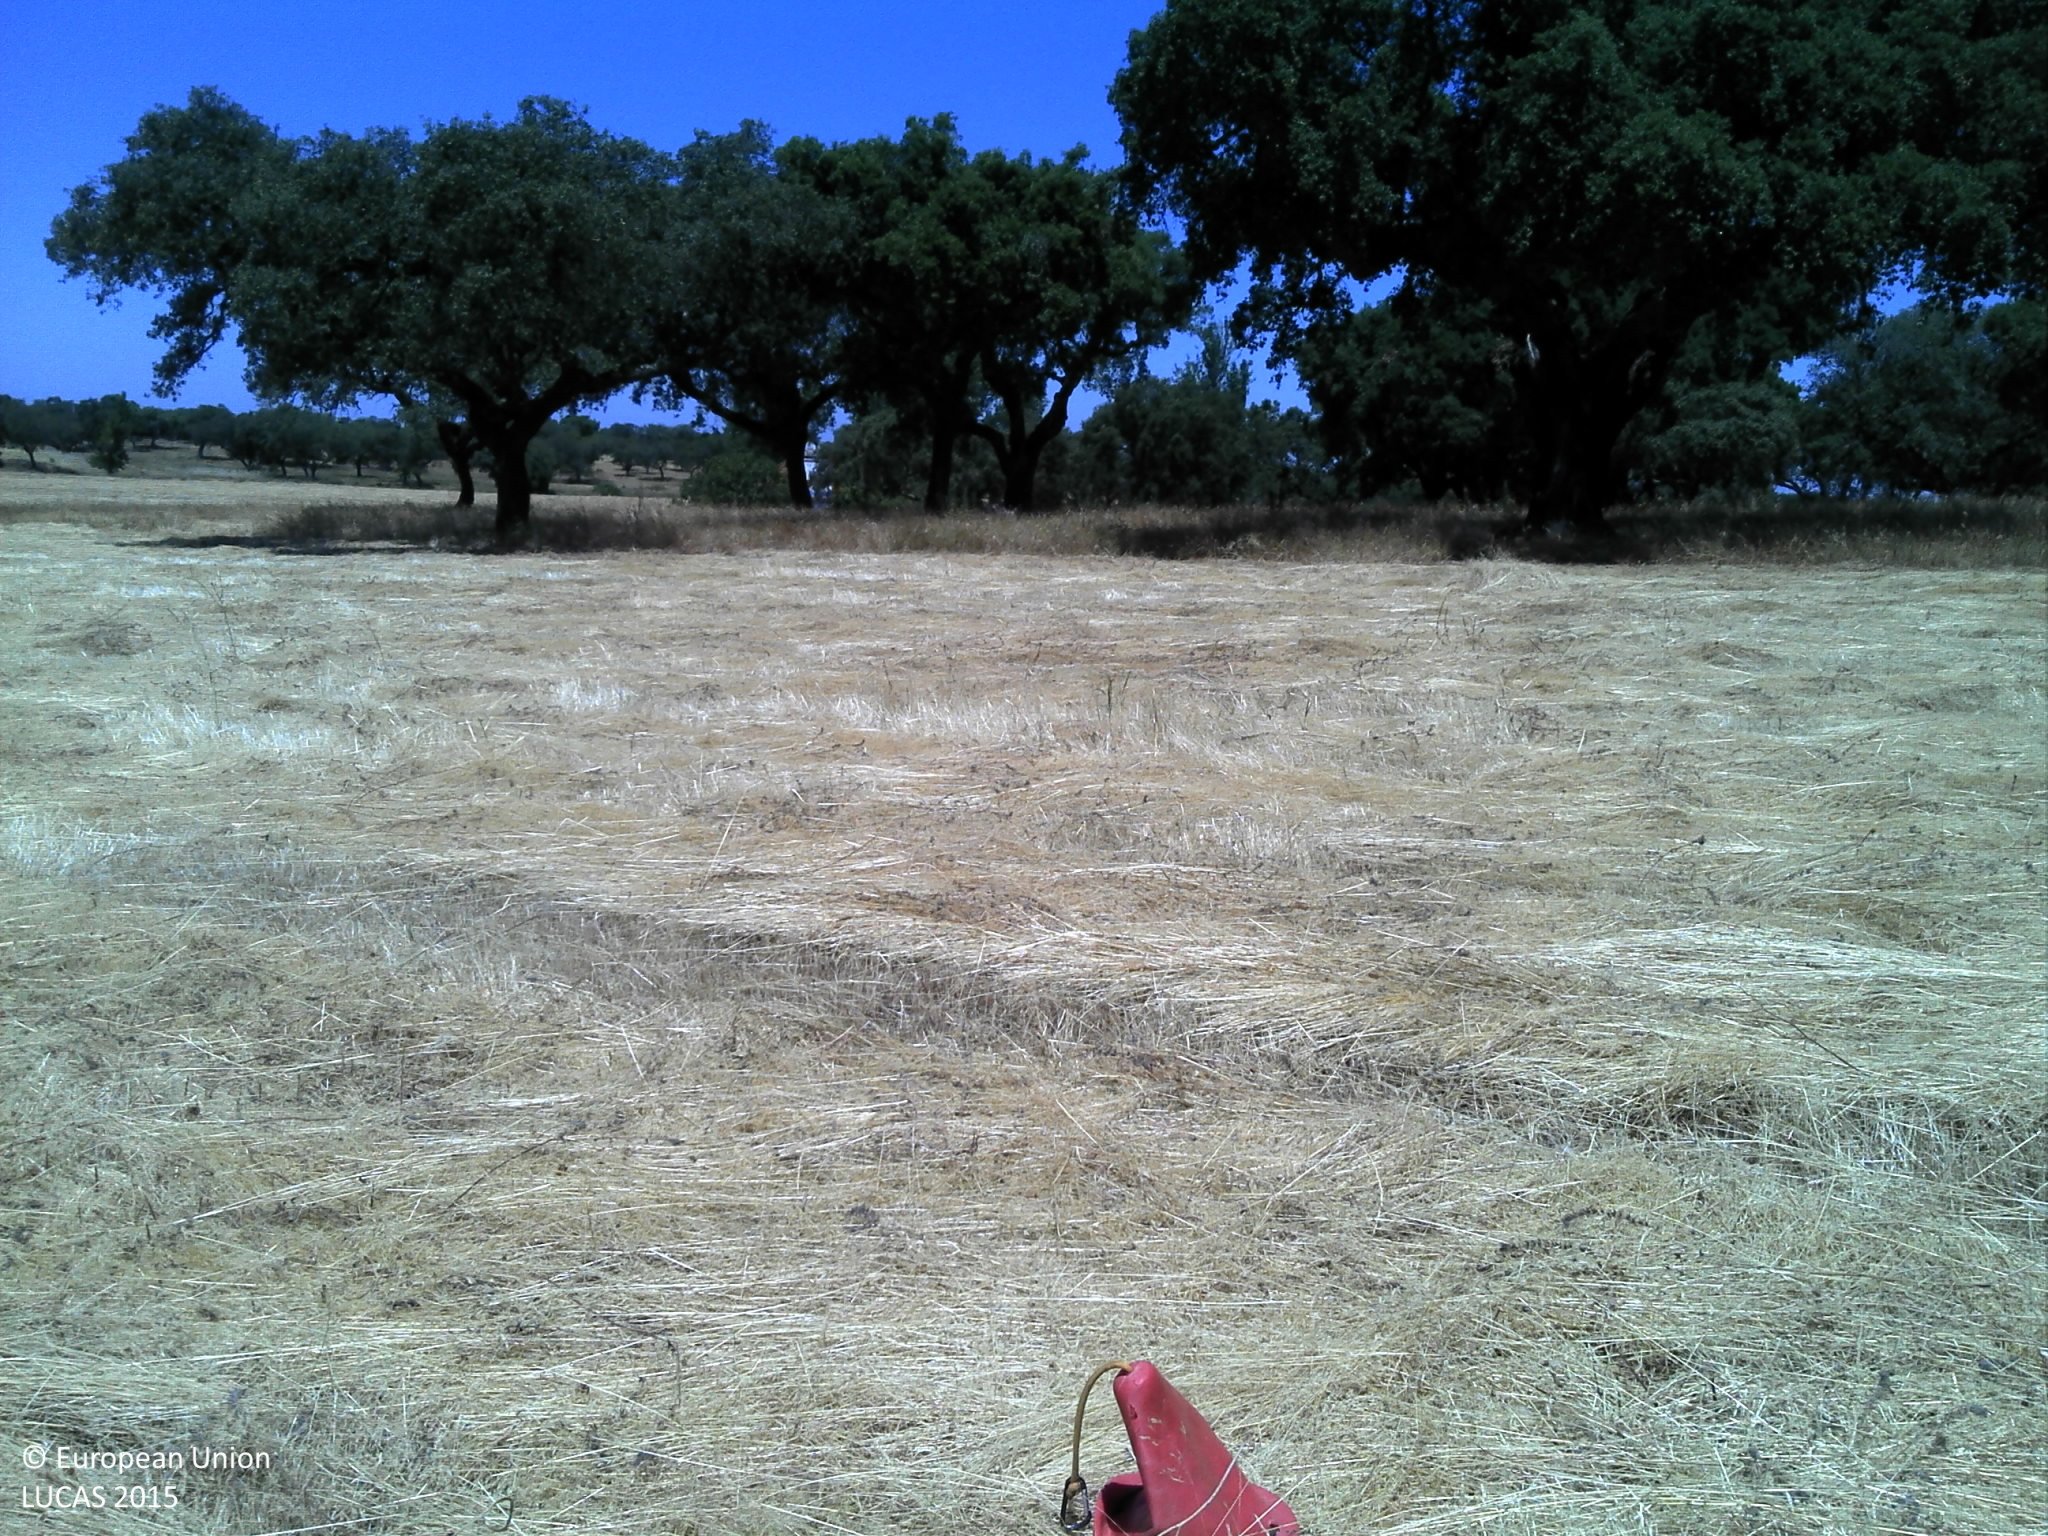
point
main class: Woodland
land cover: Broadleaved woodland
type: broadleaved evergreen forest
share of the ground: 10 - 25 %
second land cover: Grassland without tree/shrub cover
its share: 50 - 75 %
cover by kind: herbaceous plants 75 %, unconsolidated bare surface 15 %, broadleaved forest trees 10 %
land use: Forestry
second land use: Agriculture (excluding fallow land and kitchen gardens)
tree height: > 5 m
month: June
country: PT
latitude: 38.7135
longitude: -8.2089
